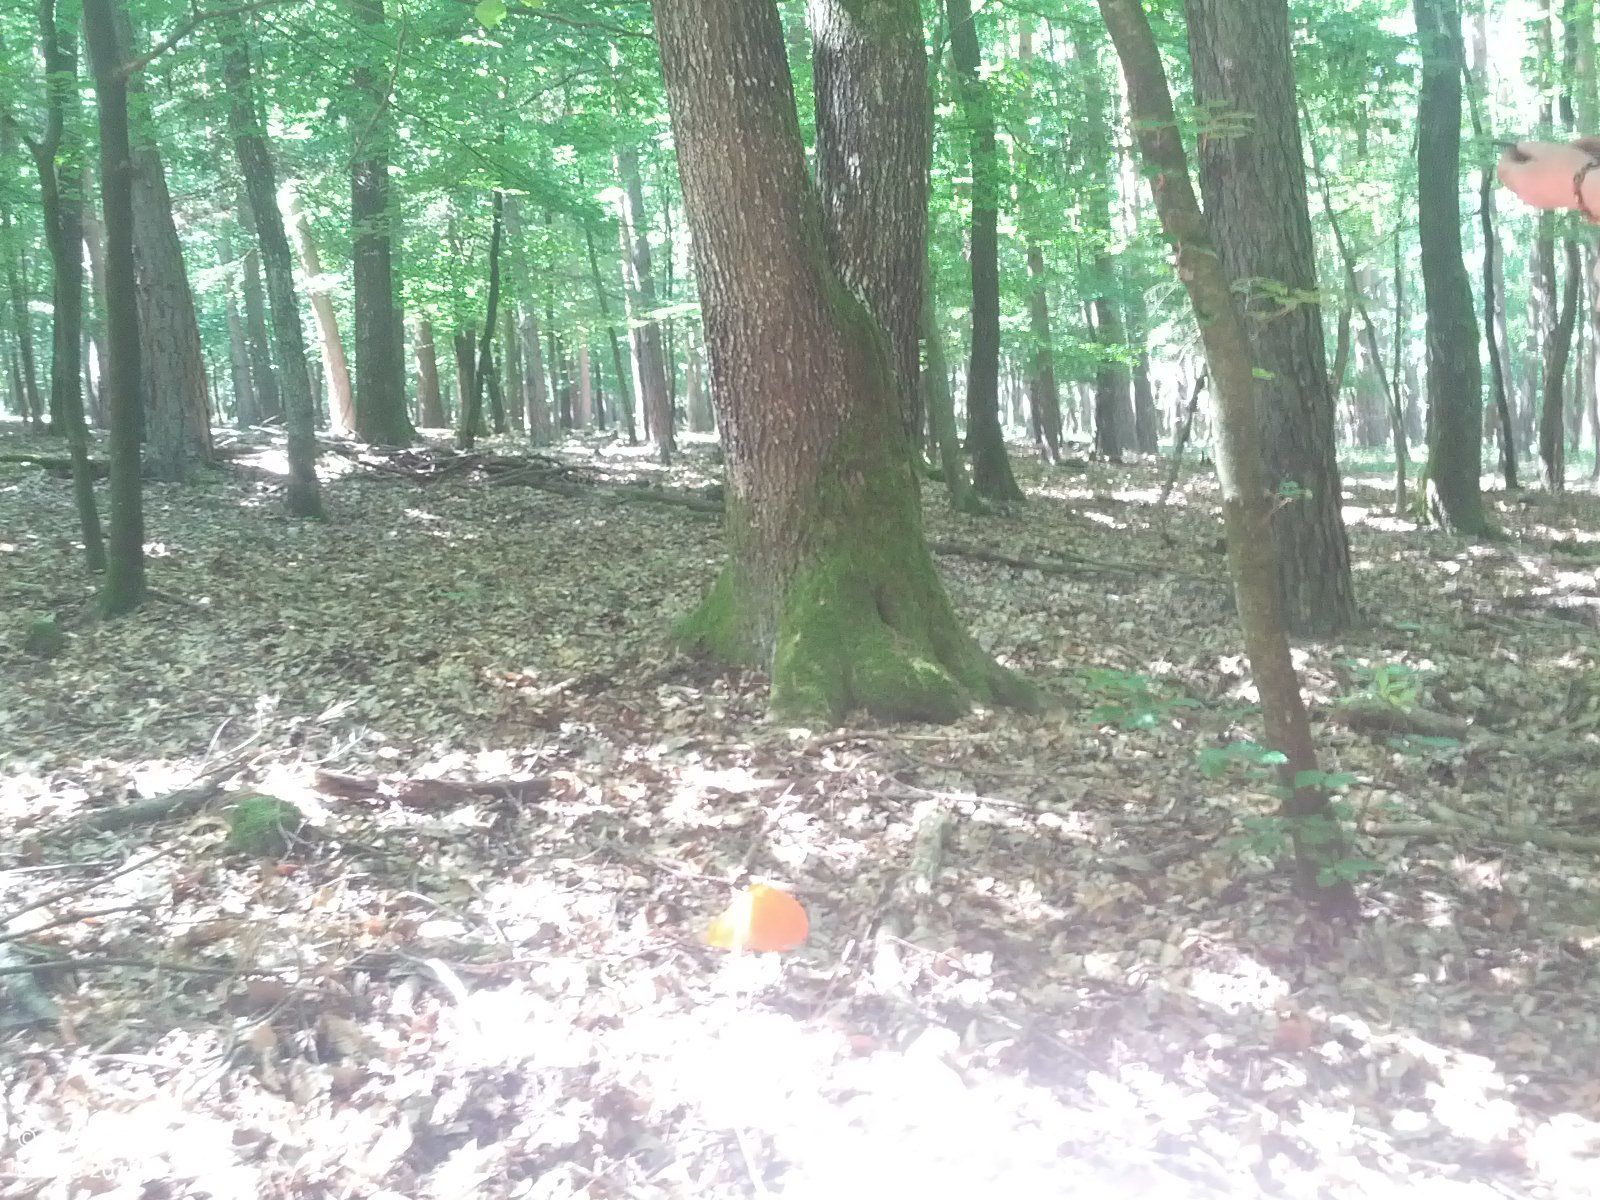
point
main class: Woodland
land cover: Pine dominated mixed woodland
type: hemiboreal forest and nemoral coniferous forest and mixed broadleaved-coniferous forest
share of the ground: > 75 %
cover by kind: coniferous forest trees 50 %, broadleaved forest trees 50 %
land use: Forestry
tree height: > 5 m
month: June
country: AT
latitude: 47.1530
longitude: 16.3991
